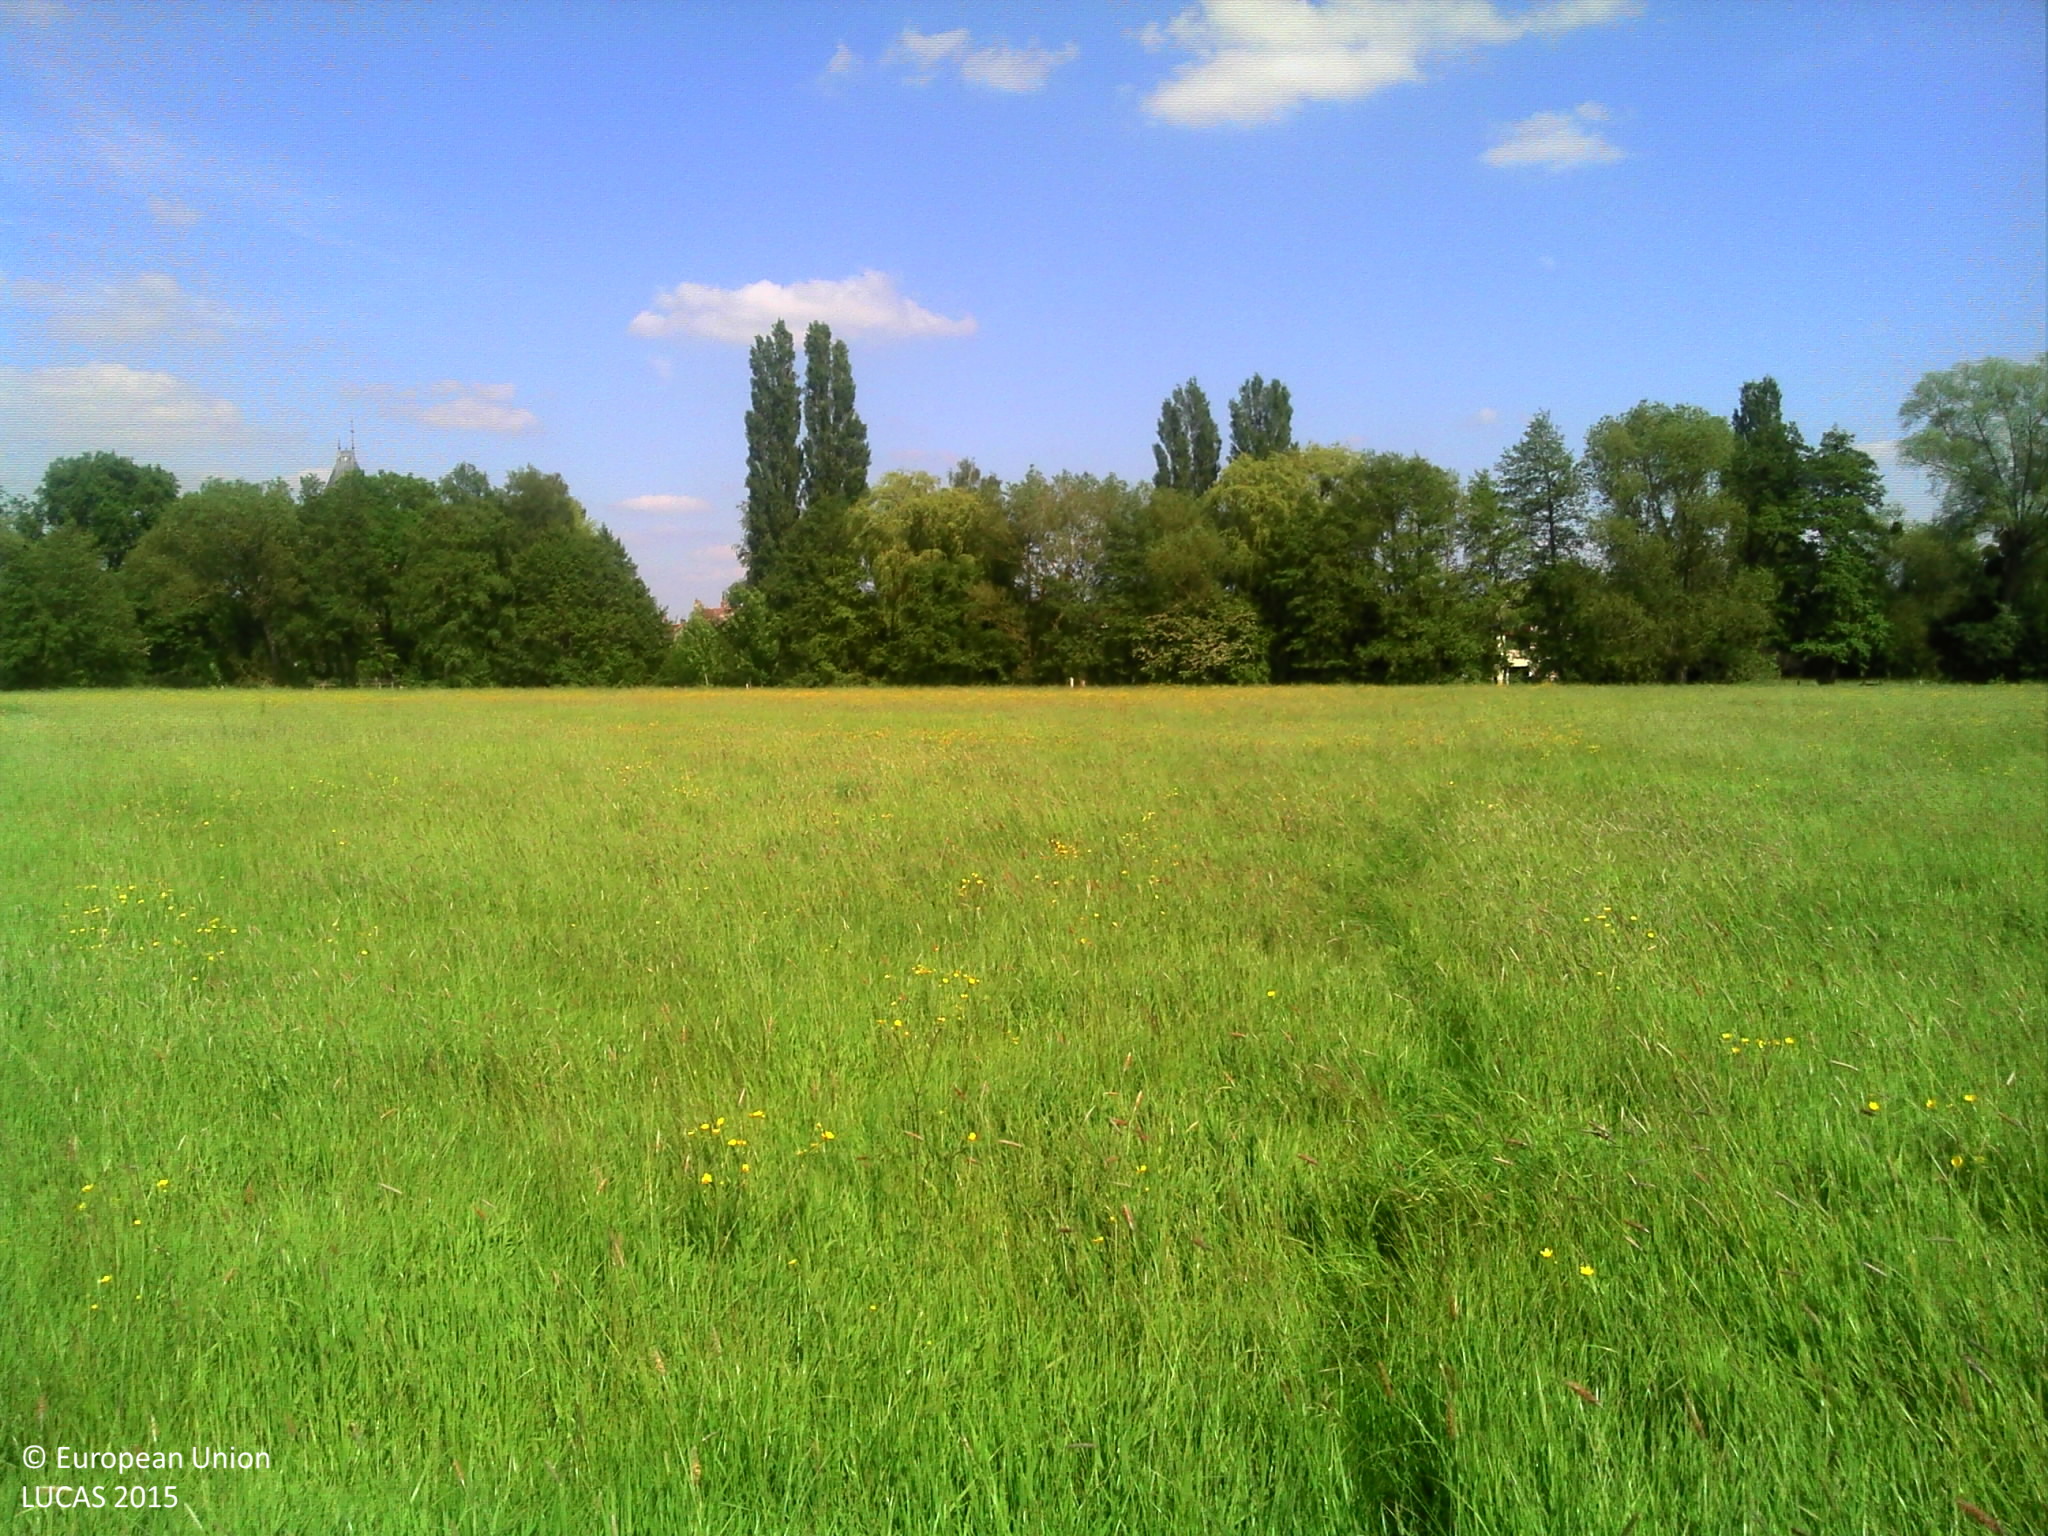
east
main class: Grassland
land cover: Grassland without tree/shrub cover
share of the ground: > 75 %
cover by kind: herbaceous plants 95 %, shrubs 5 %
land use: Agriculture (excluding fallow land and kitchen gardens)
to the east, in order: Grassland without tree/shrub cover; Fences; Rivers and streams; Abandoned hedges; Artificial constructions in urban areas
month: May
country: FR
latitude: 48.7167
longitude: -0.1301
